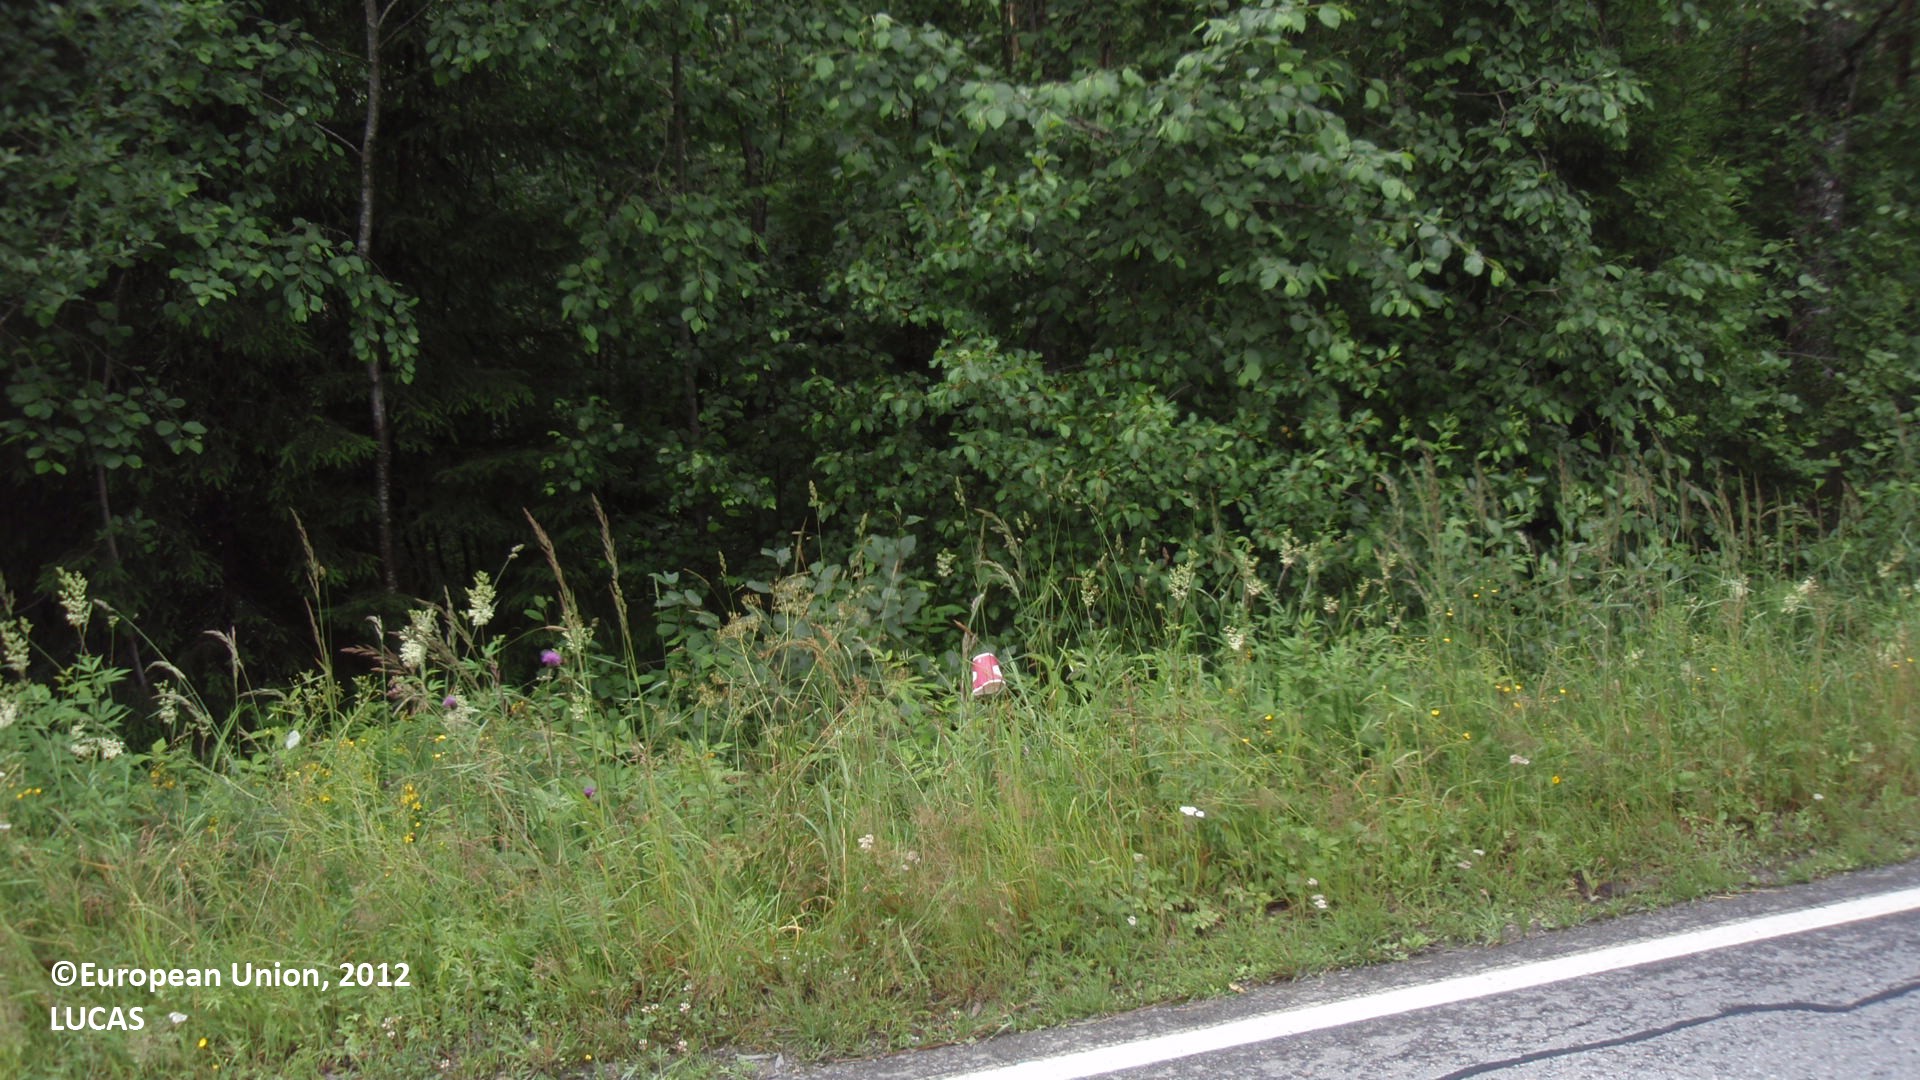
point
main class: Grassland
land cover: Grassland with sparse tree/shrub cover
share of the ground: > 75 %
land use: Road transport
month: July
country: FI
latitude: 61.5156
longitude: 27.2166
